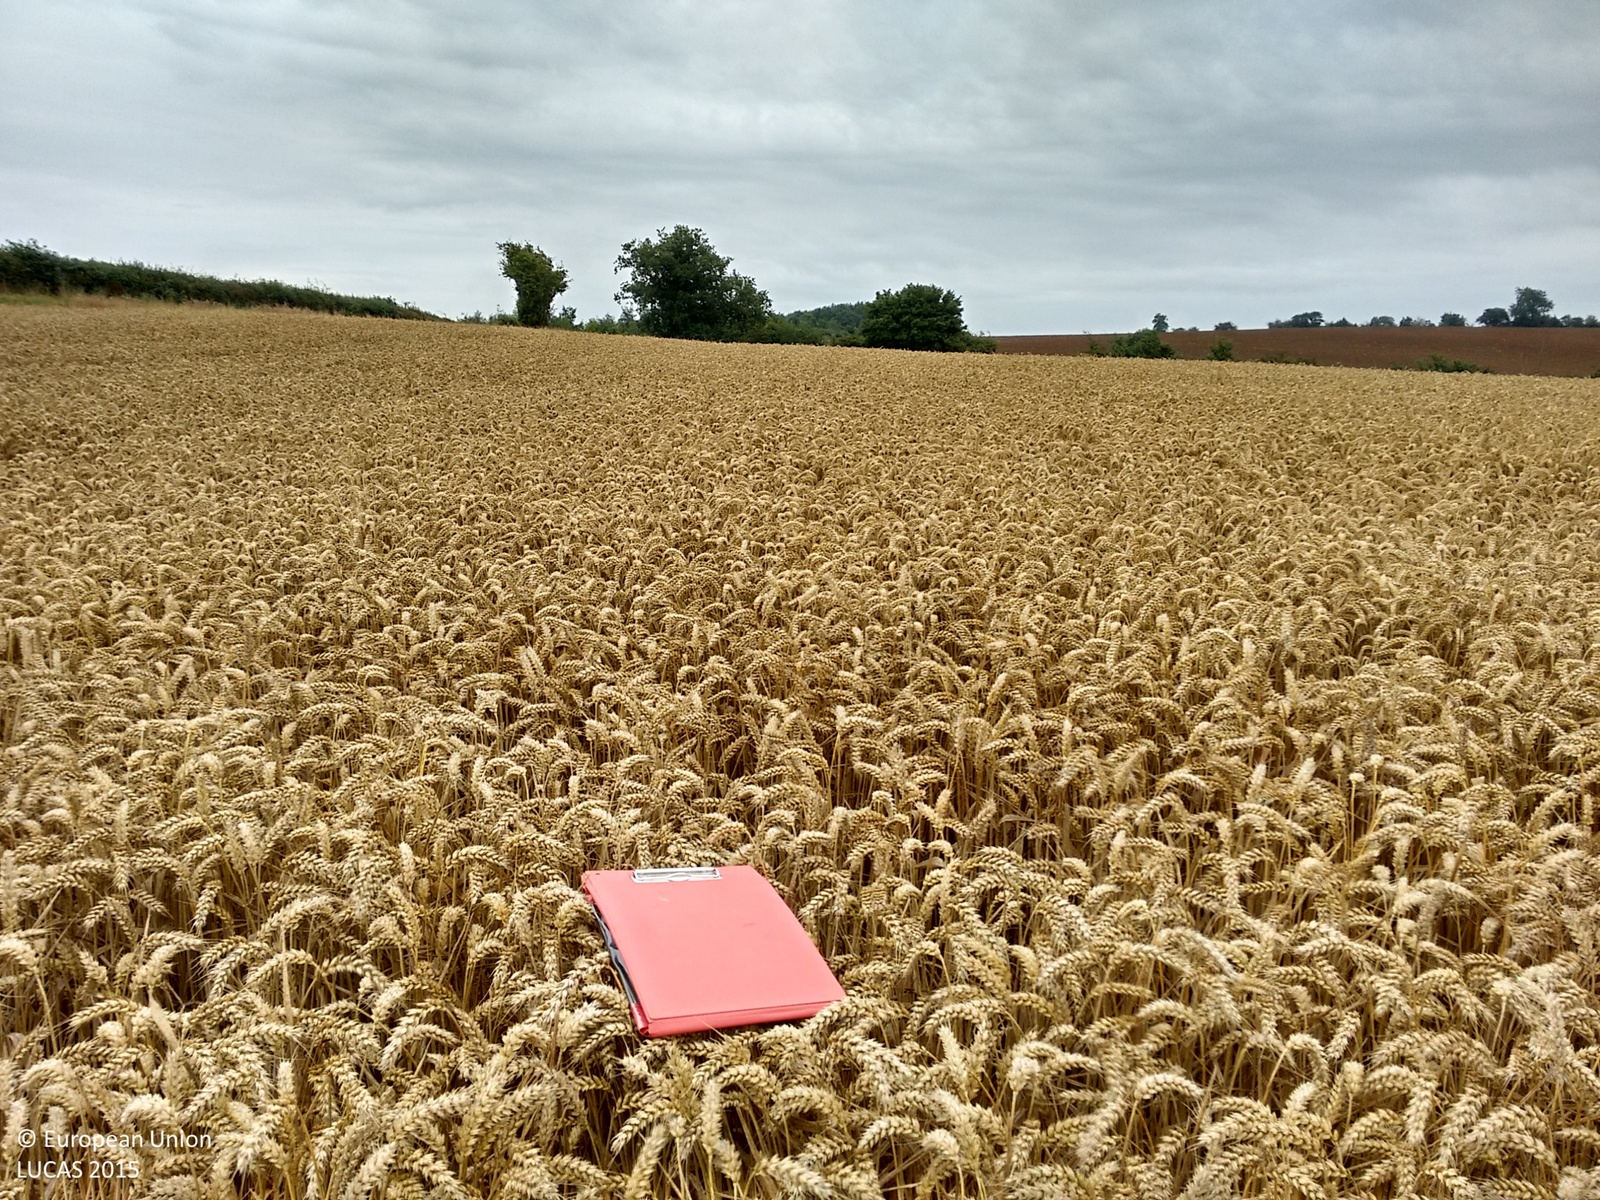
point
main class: Cropland
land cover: Common wheat
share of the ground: > 75 %
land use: Agriculture (excluding fallow land and kitchen gardens)
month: August
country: GB
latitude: 52.1488
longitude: -1.2570
